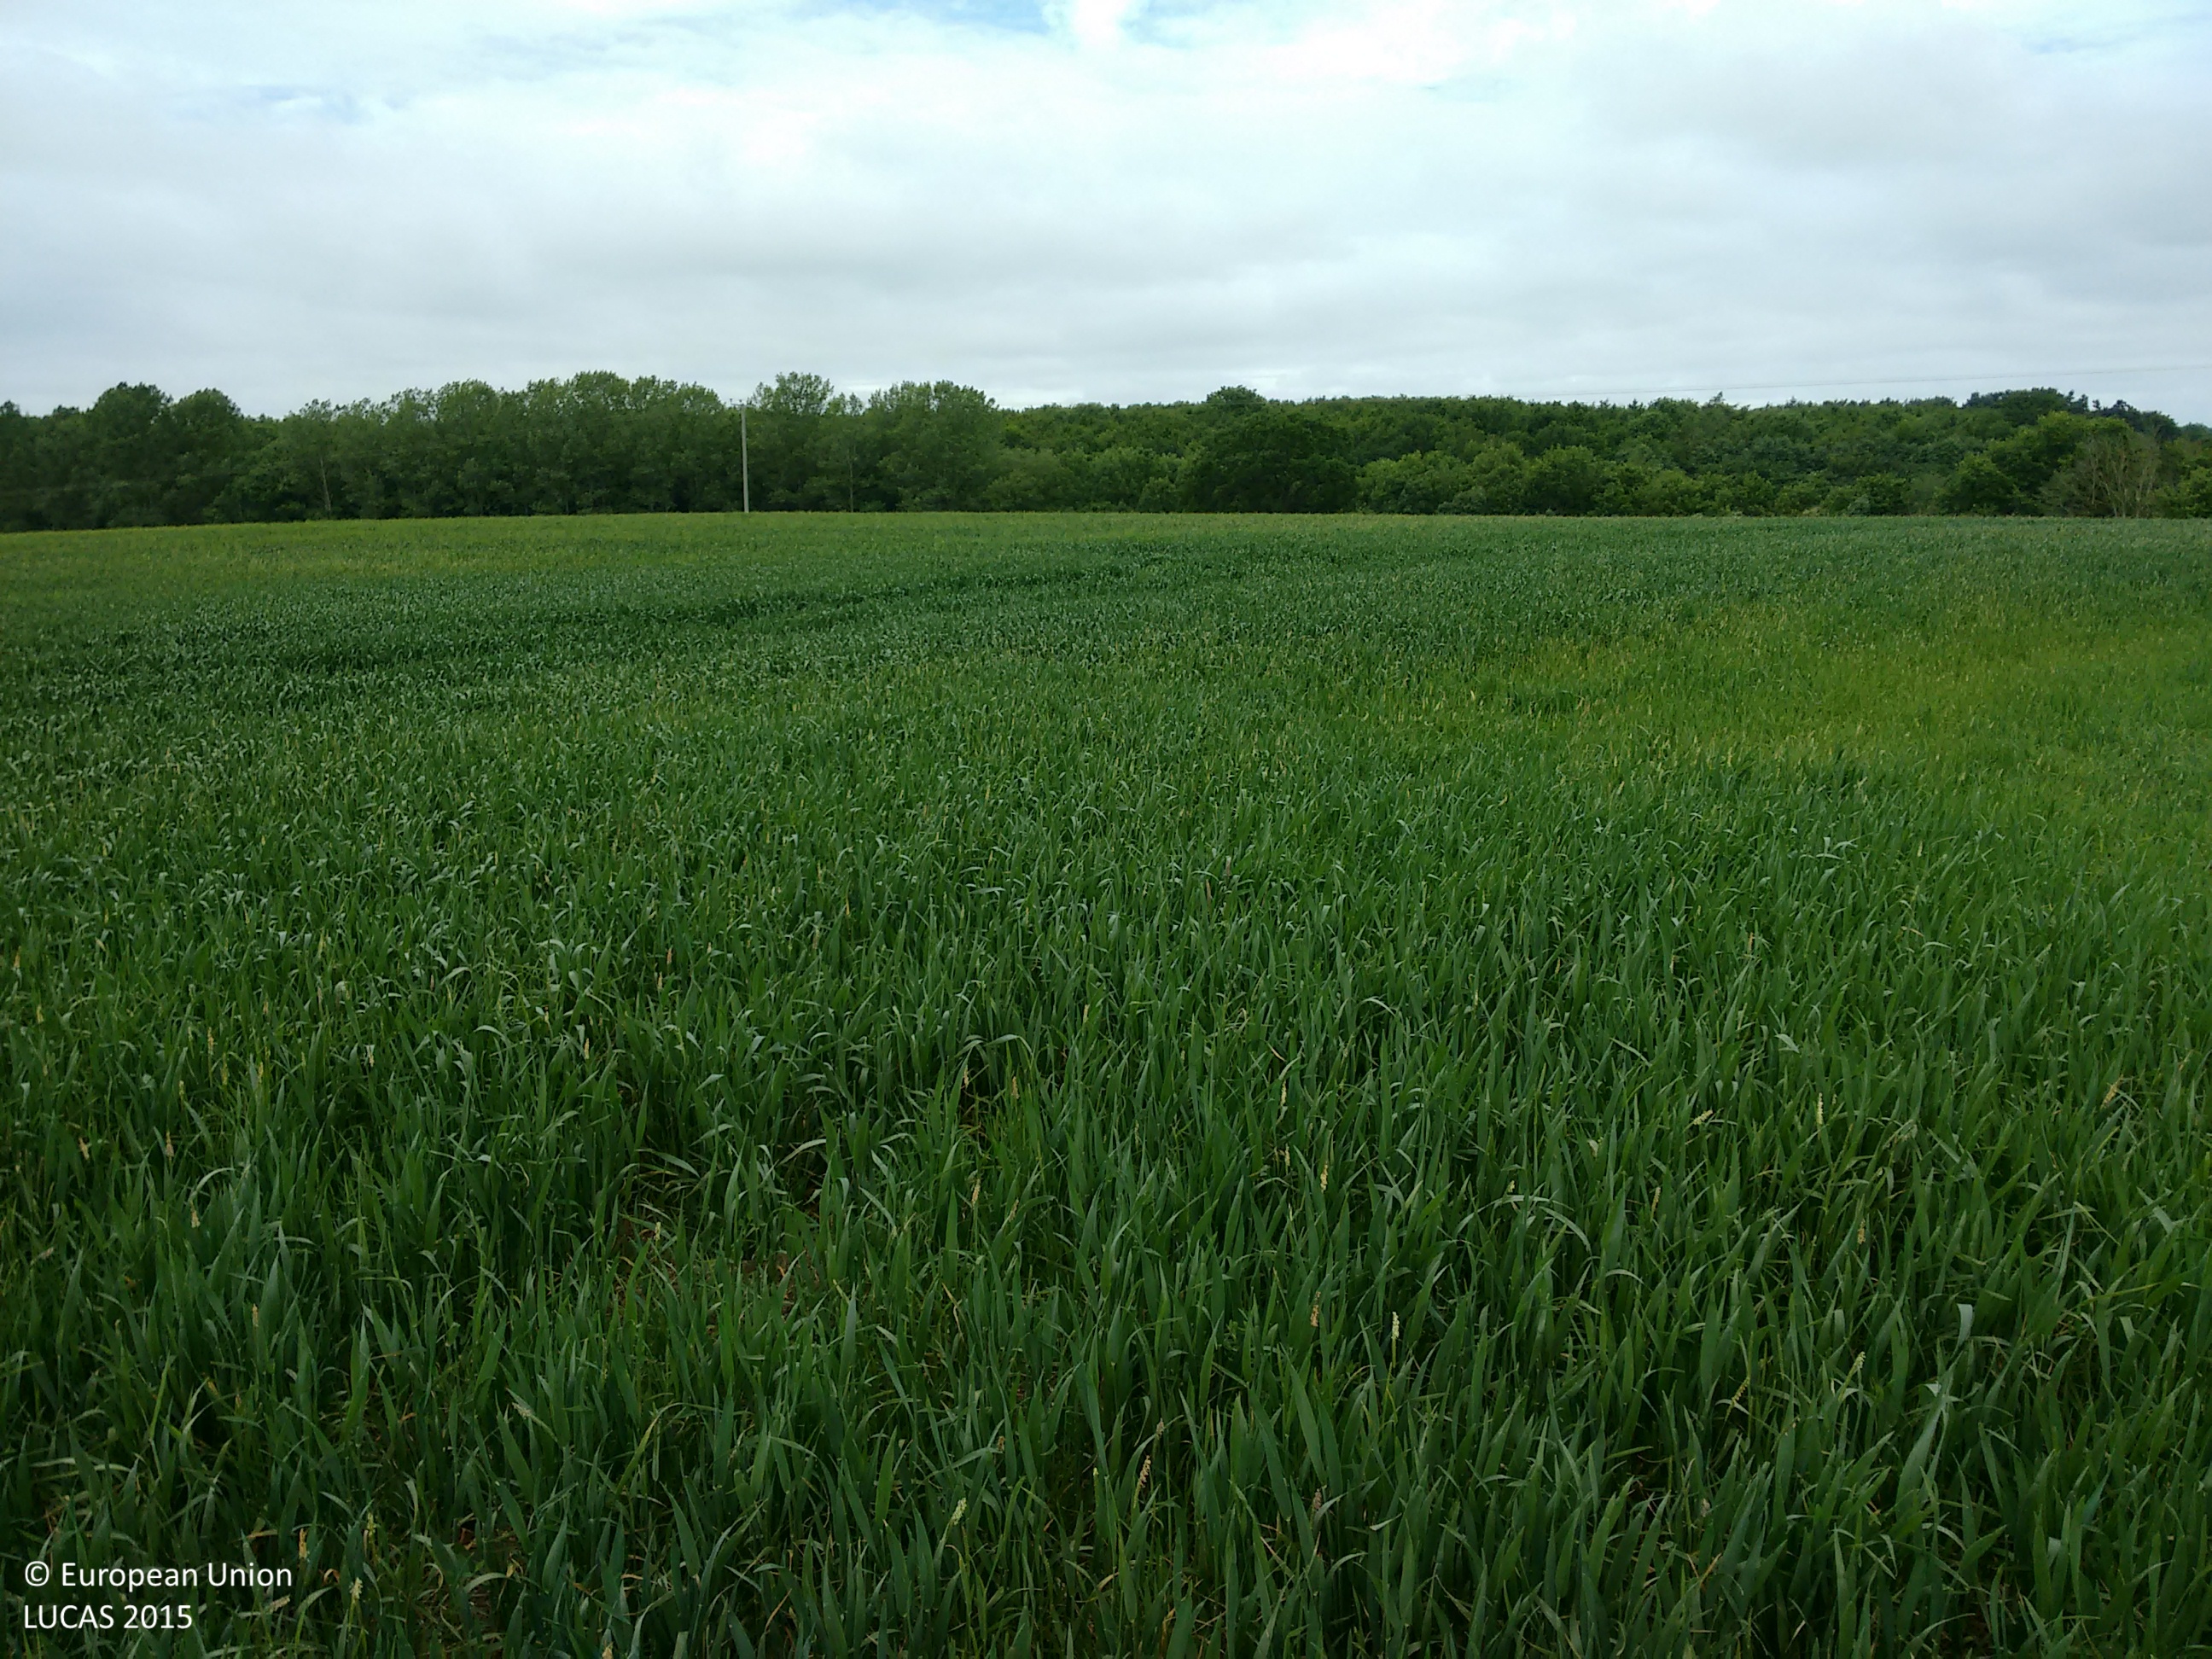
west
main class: Cropland
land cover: Common wheat
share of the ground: > 75 %
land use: Agriculture (excluding fallow land and kitchen gardens)
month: June
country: GB
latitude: 52.1140
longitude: -0.6565
